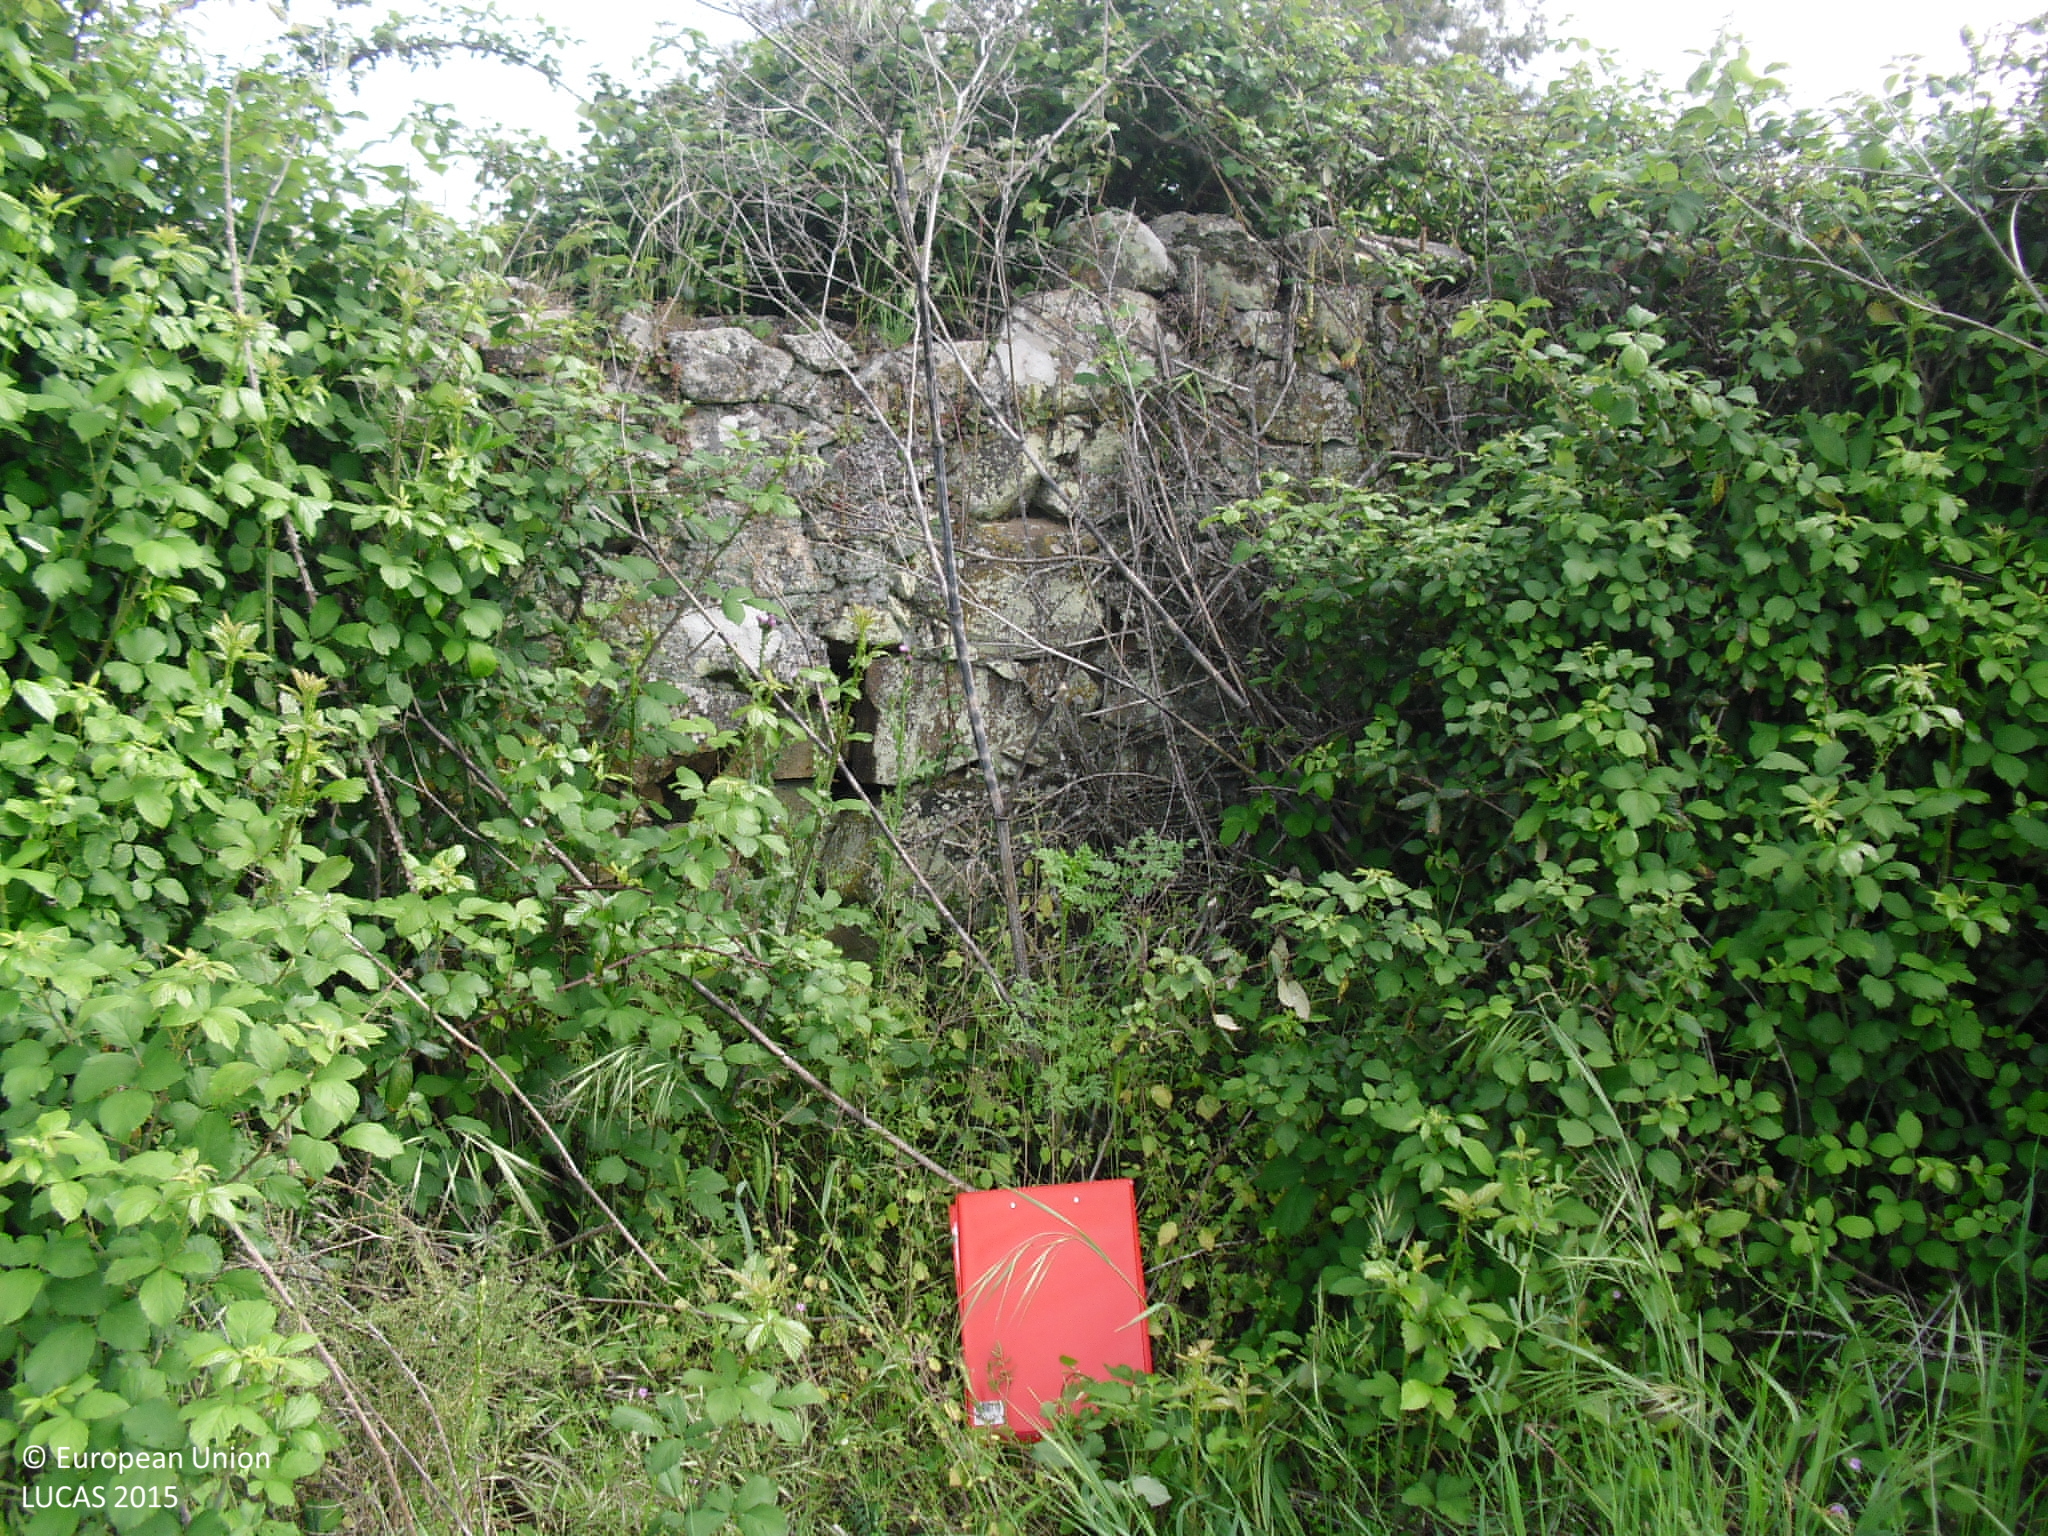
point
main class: Grassland
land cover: Grassland without tree/shrub cover
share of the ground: > 75 %
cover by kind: herbaceous plants 95 %, shrubs 5 %
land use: Agriculture (excluding fallow land and kitchen gardens)
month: April
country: ES
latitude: 39.3296
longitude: -6.0093
